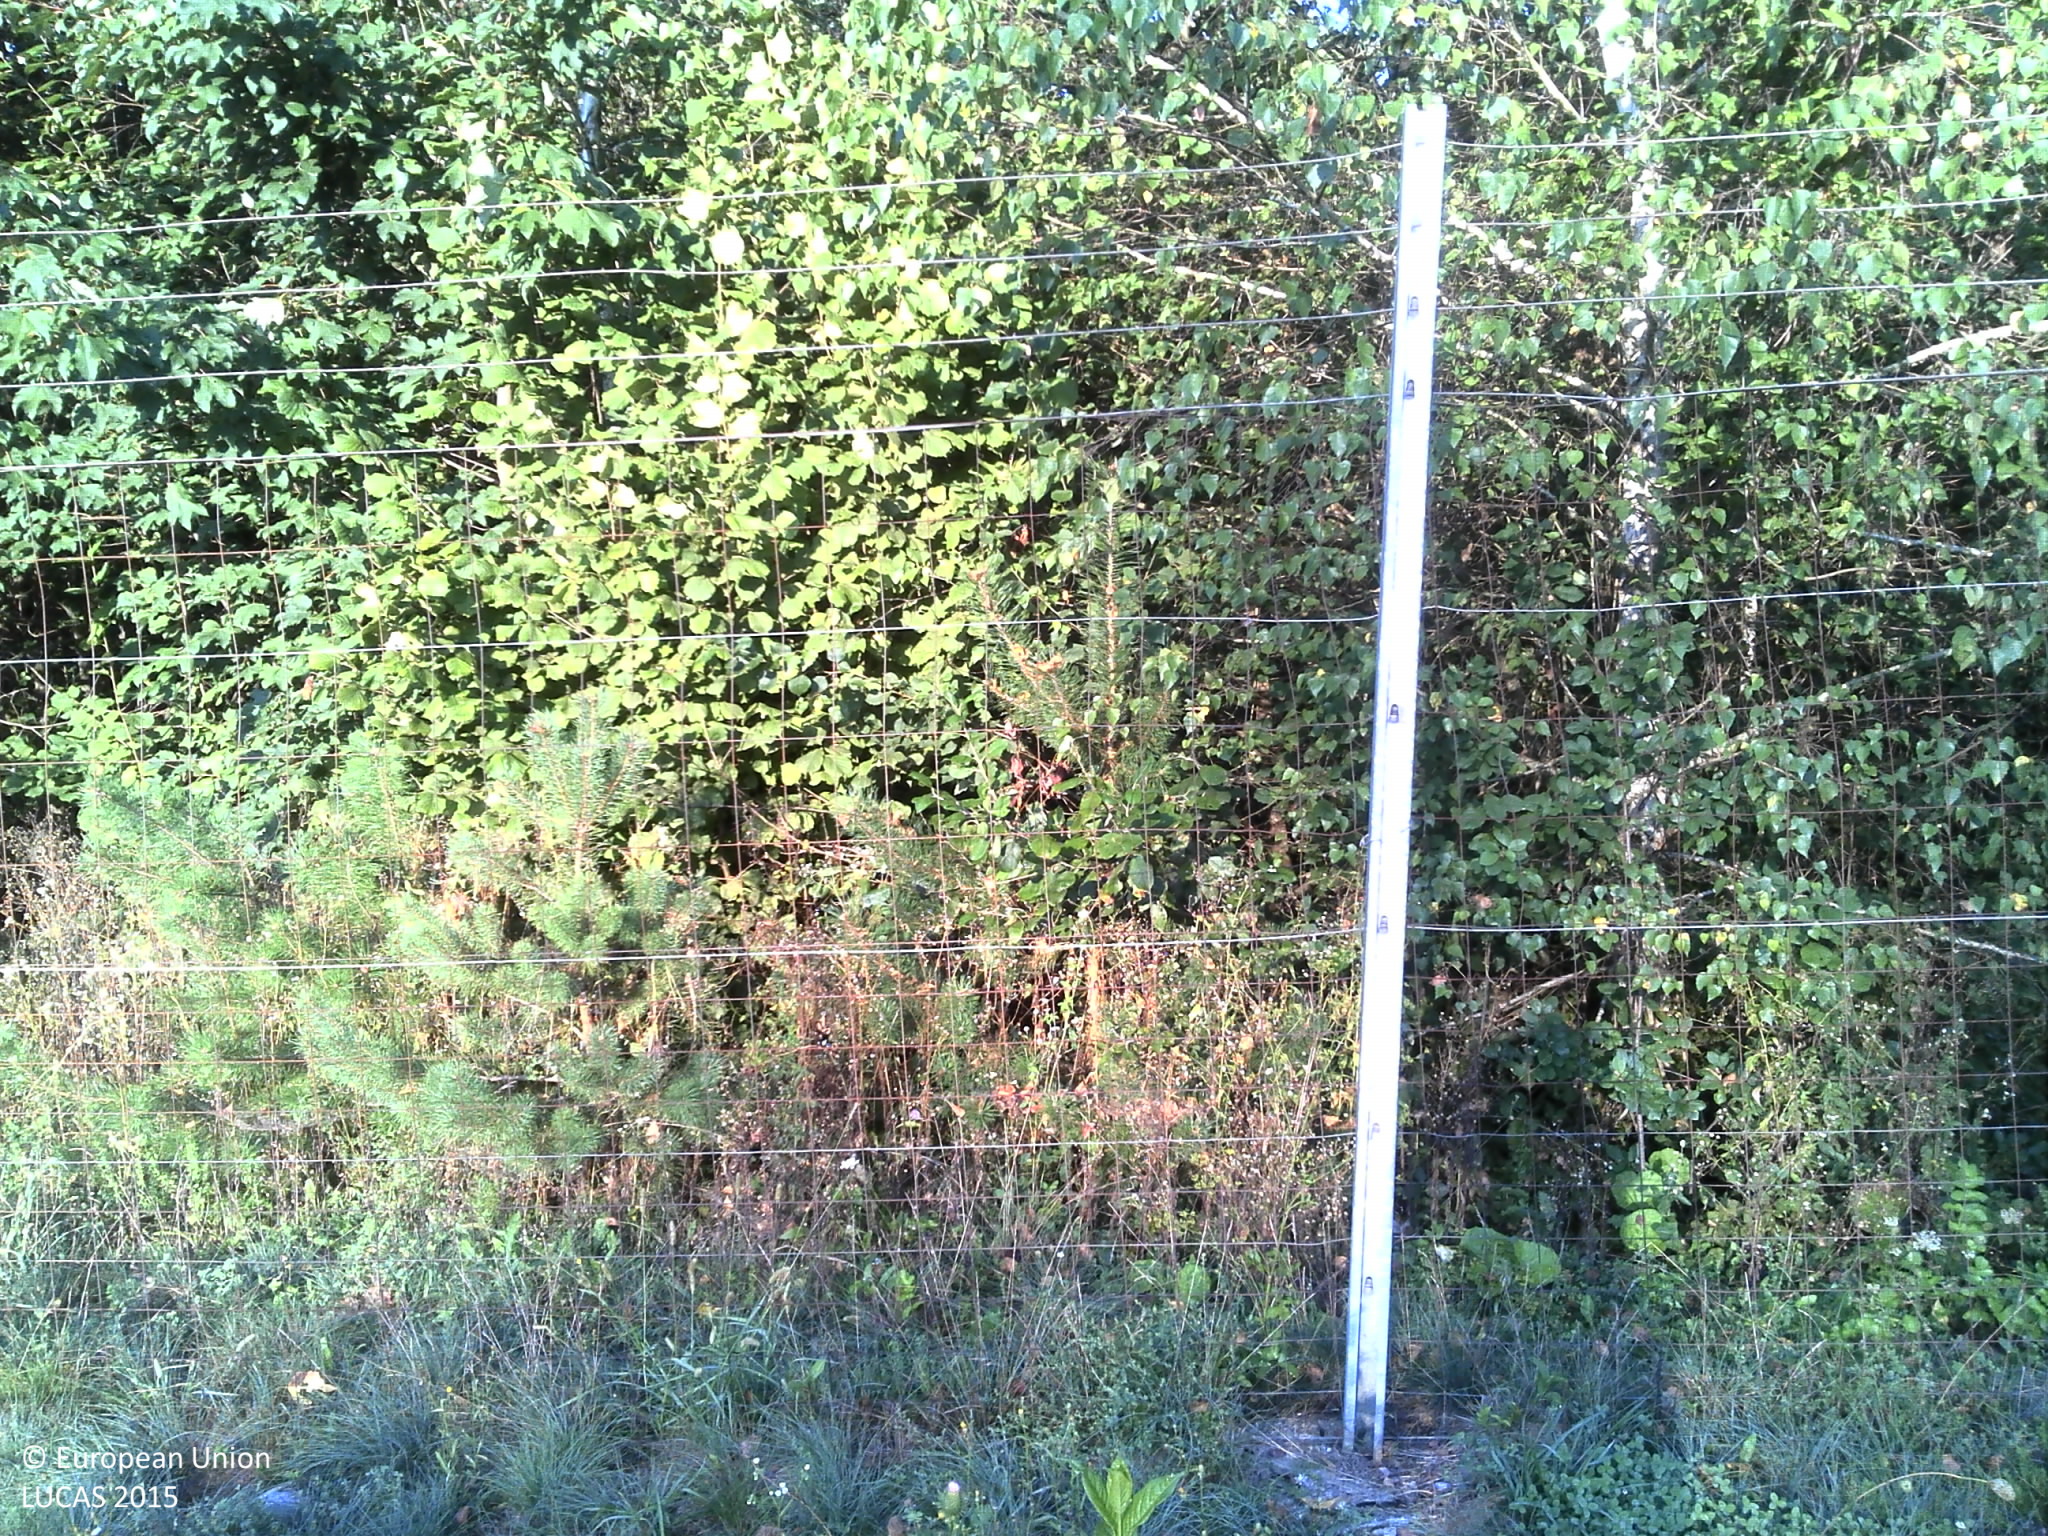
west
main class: Grassland
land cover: Spontaneously vegetated surfaces
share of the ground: > 75 %
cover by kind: herbaceous plants 100 %
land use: Road transport
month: September
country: HR
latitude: 45.3728
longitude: 15.2692
